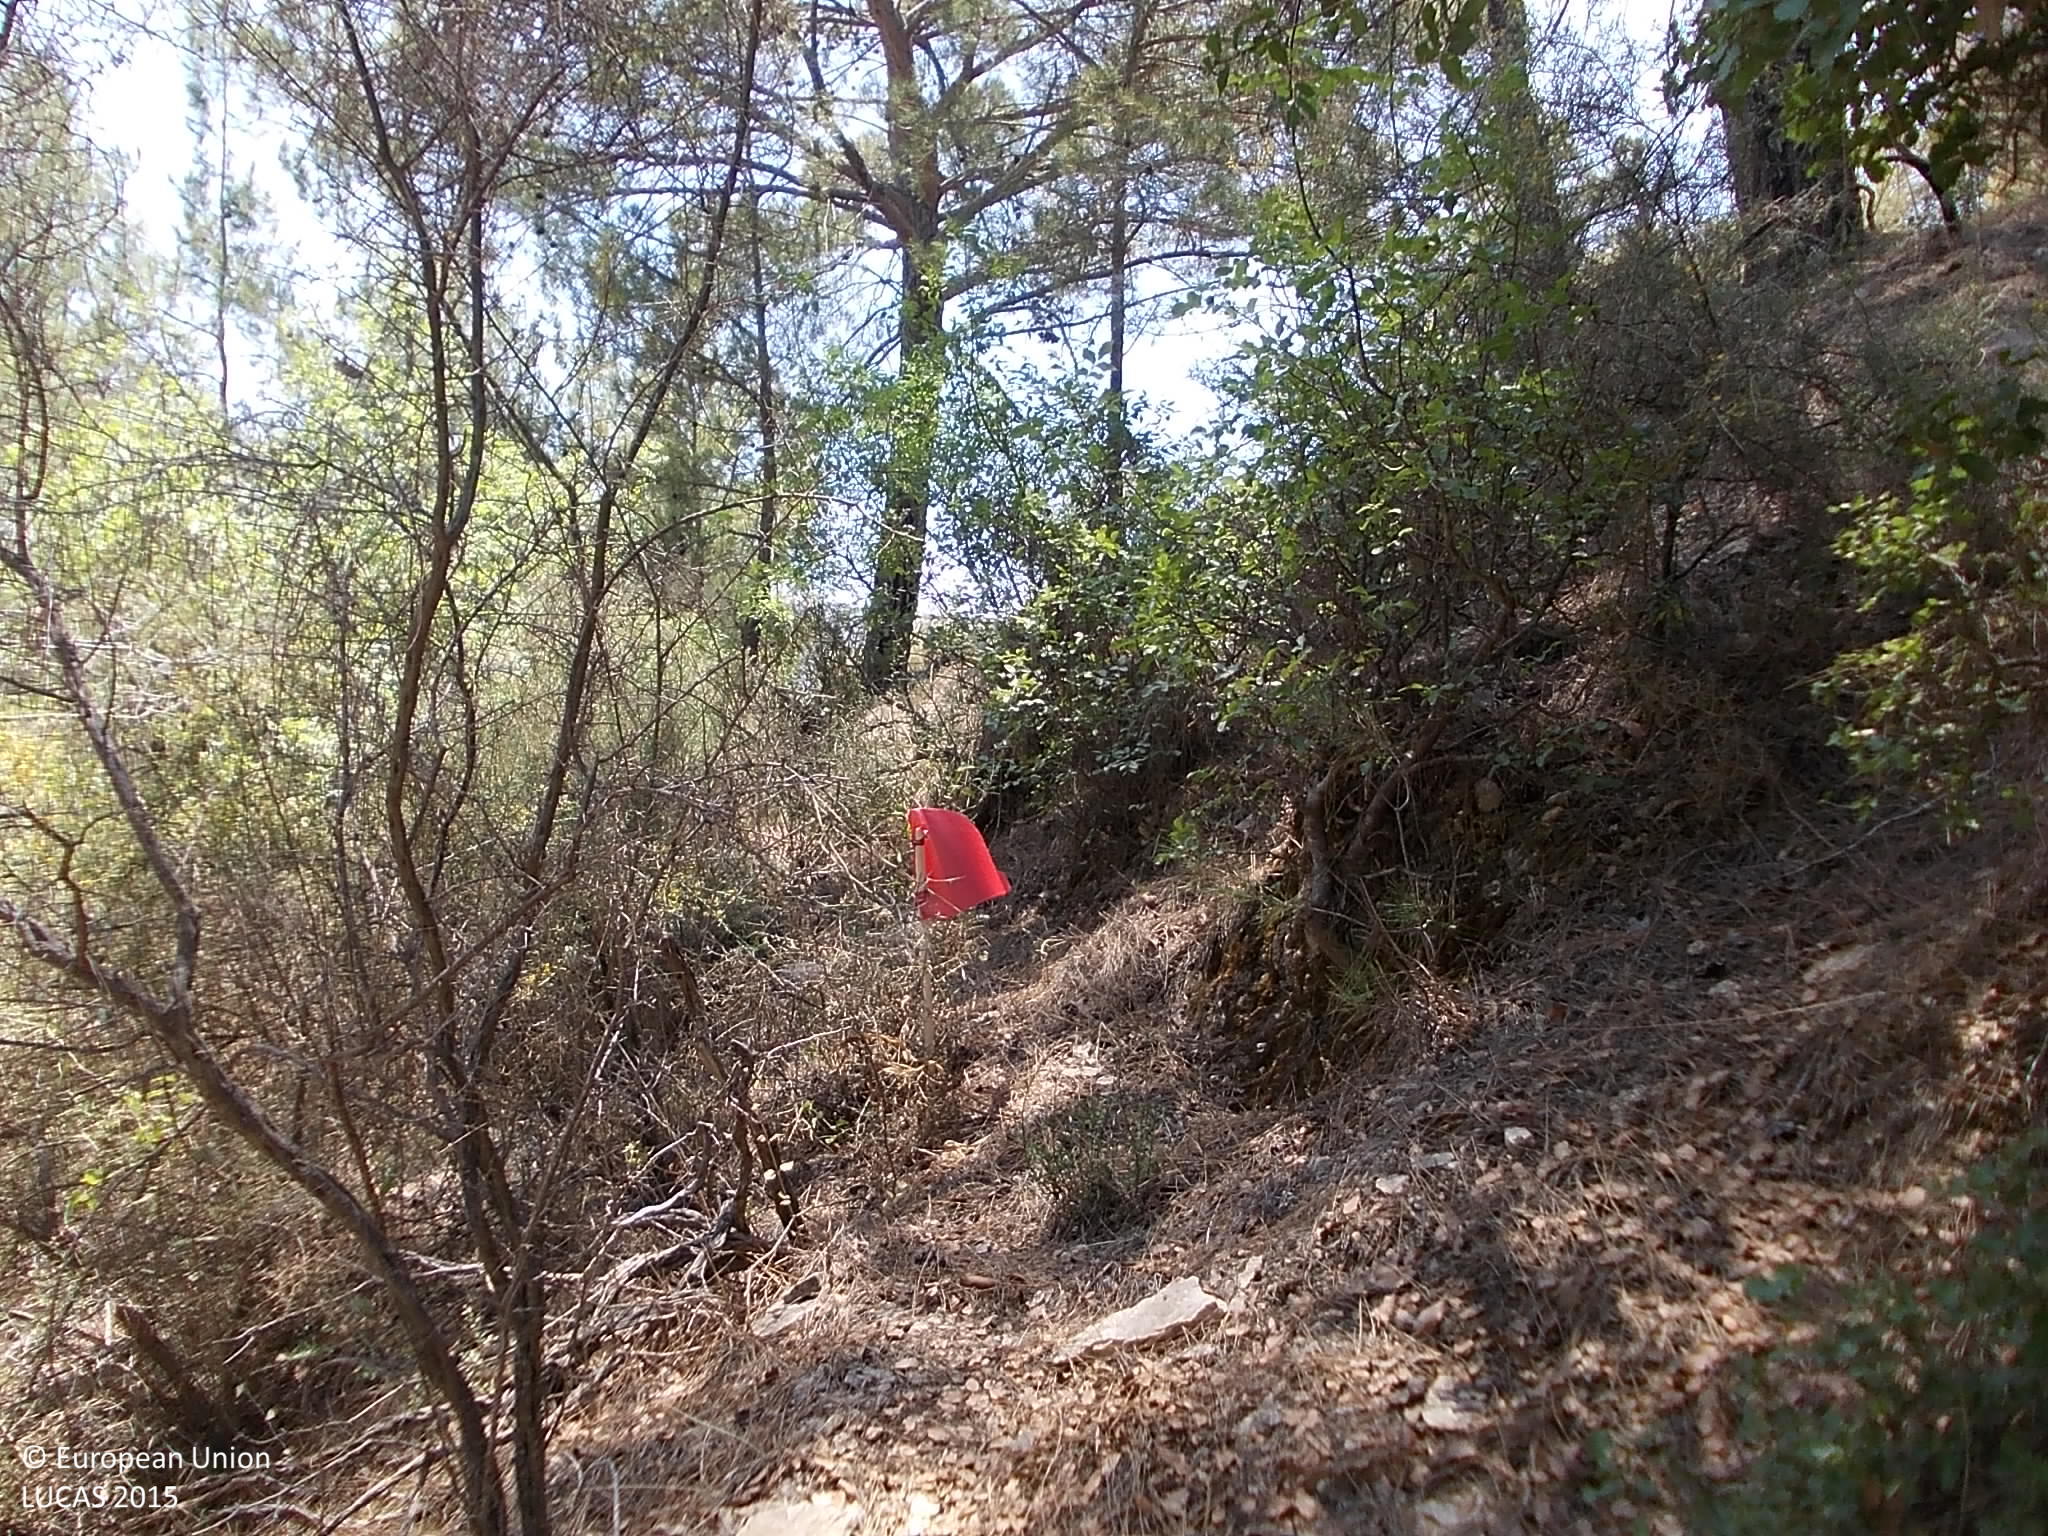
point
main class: Woodland
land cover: Pine dominated coniferous woodland
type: coniferous forest of the mediterranean region
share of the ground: > 75 %
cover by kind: coniferous forest trees 75 %, shrubs 10 %, unconsolidated bare surface 10 %, broadleaved forest trees 5 %
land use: Semi-natural and natural areas not in use
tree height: > 5 m
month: July
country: CY
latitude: 34.7544
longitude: 32.7132
